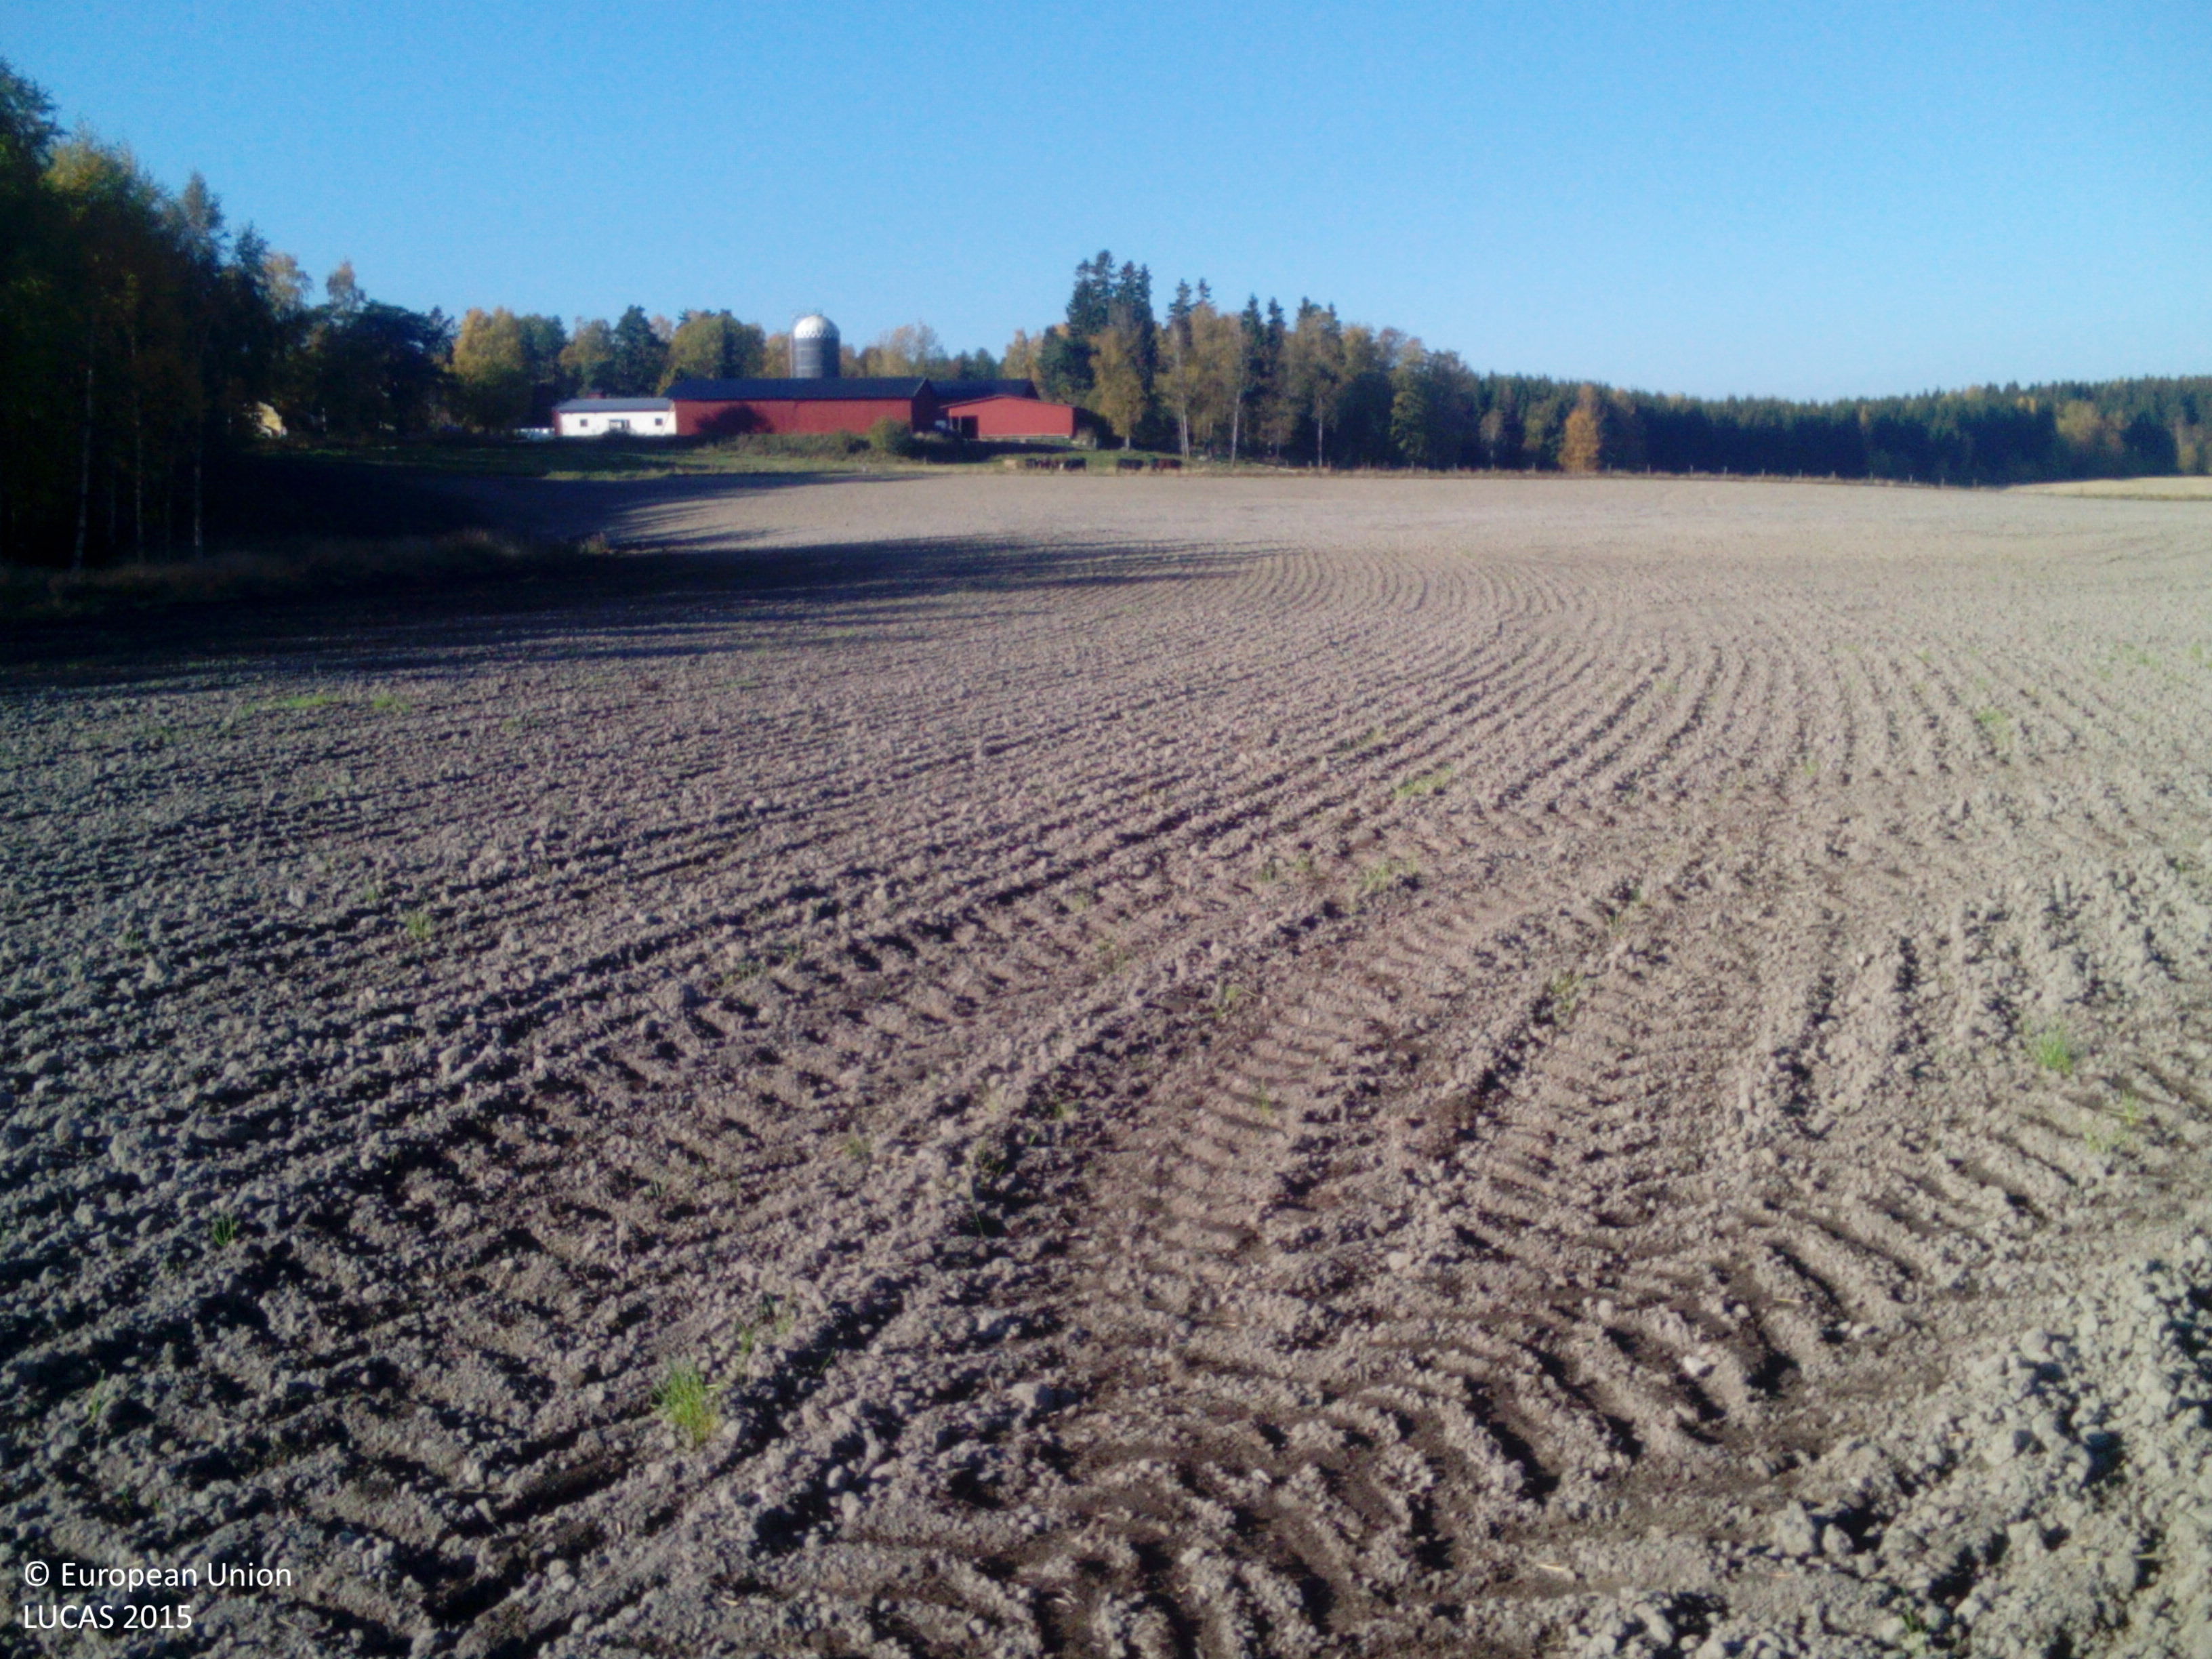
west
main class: Cropland
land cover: Common wheat
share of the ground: < 10 %
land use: Agriculture (excluding fallow land and kitchen gardens)
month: October
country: SE
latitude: 58.9106
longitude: 16.5056
